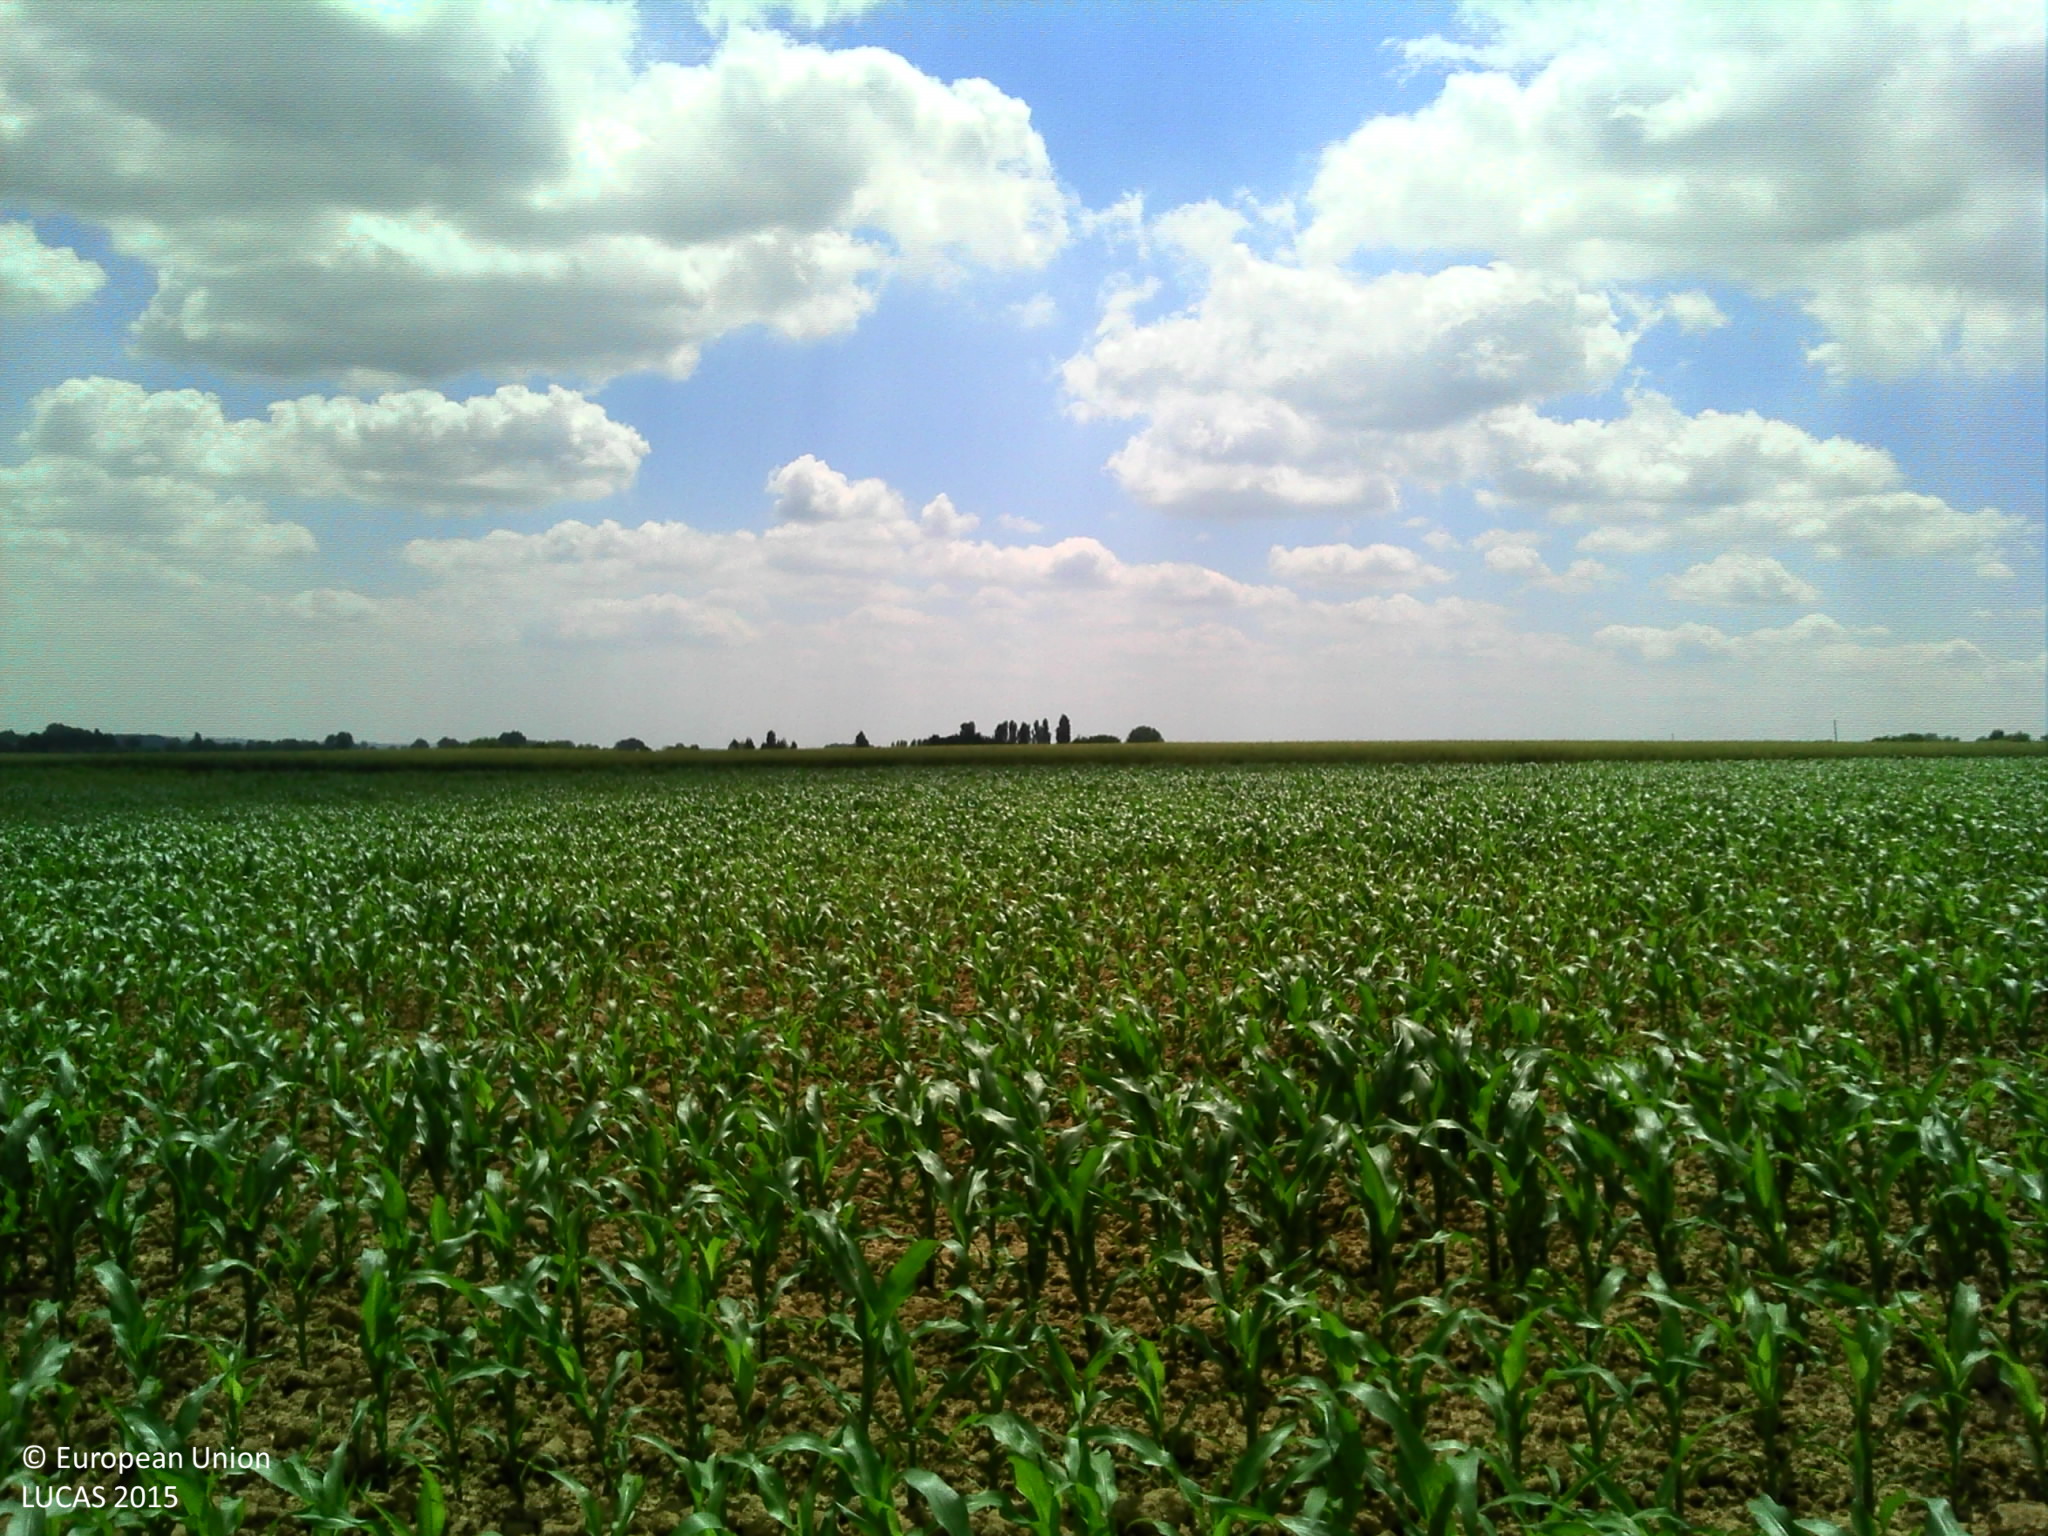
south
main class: Cropland
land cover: Maize
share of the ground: 25 - 50 %
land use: Agriculture (excluding fallow land and kitchen gardens)
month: June
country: FR
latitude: 48.2732
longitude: 0.1774
